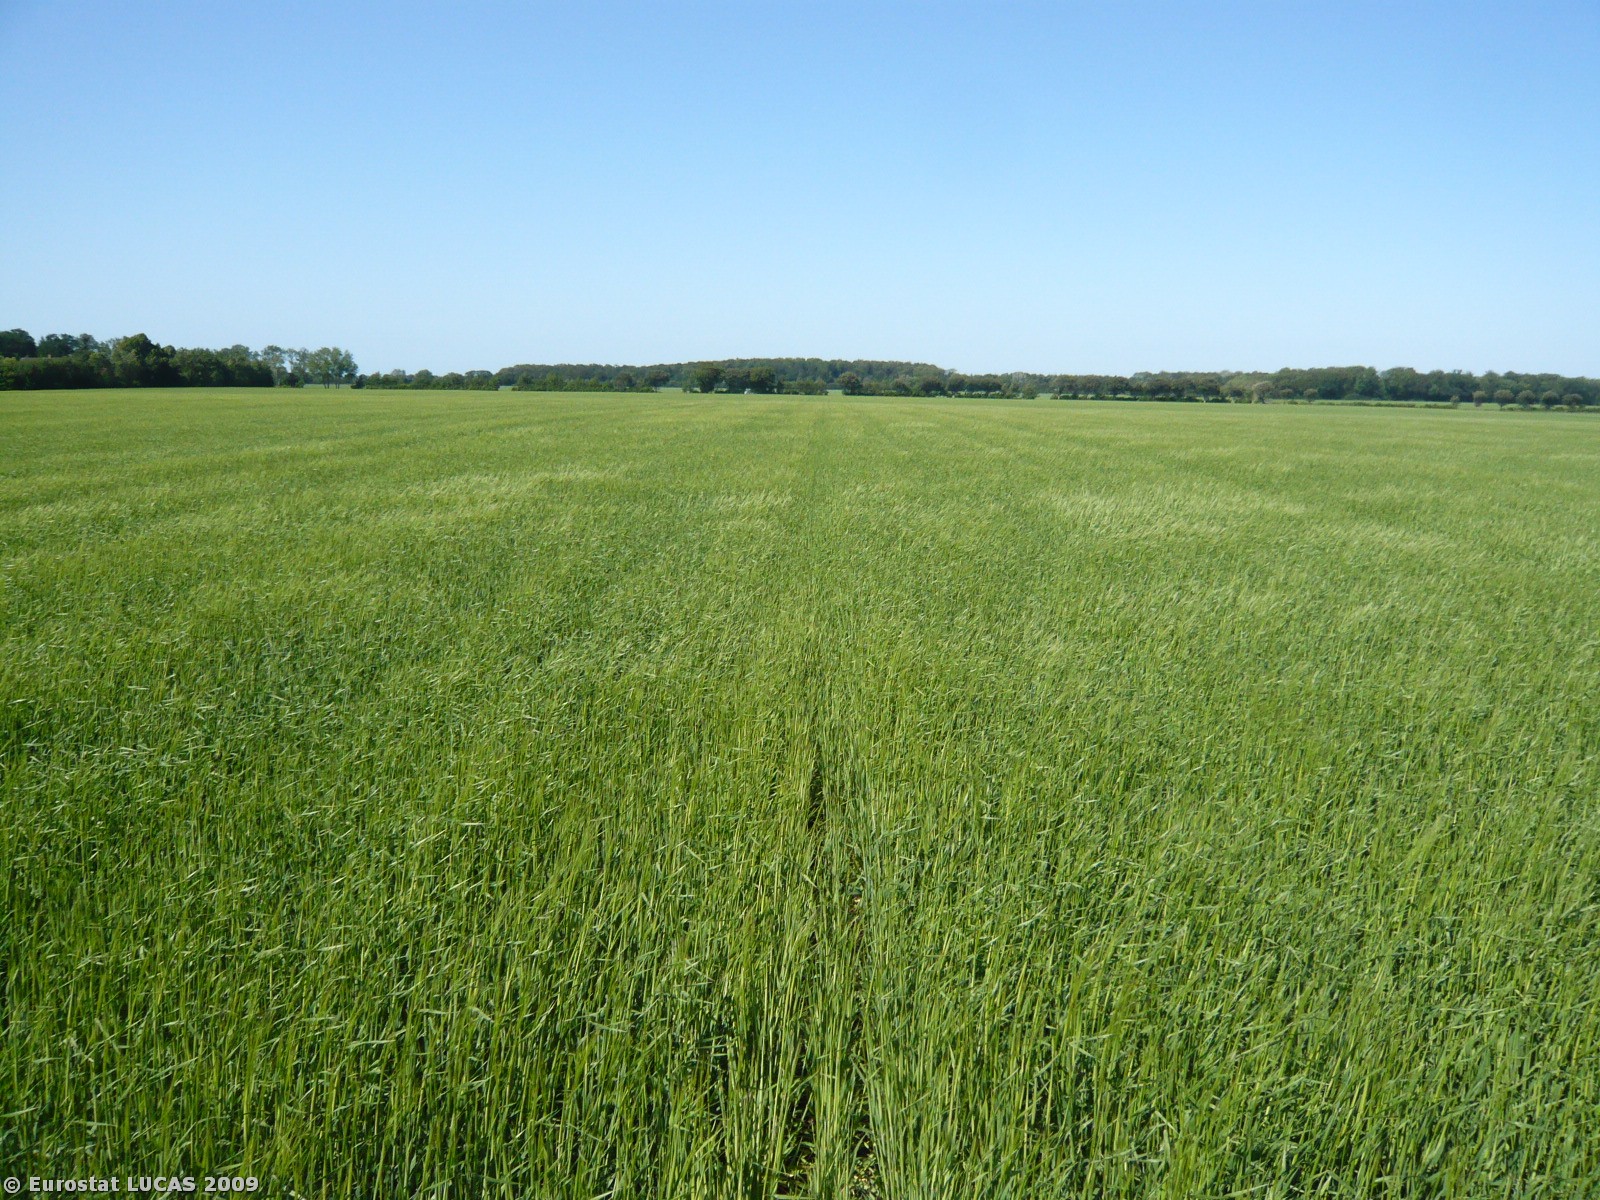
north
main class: Cropland
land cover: Barley
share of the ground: > 75 %
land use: Agriculture (excluding fallow land and kitchen gardens)
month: June
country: DK
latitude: 54.7797
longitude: 11.2274
